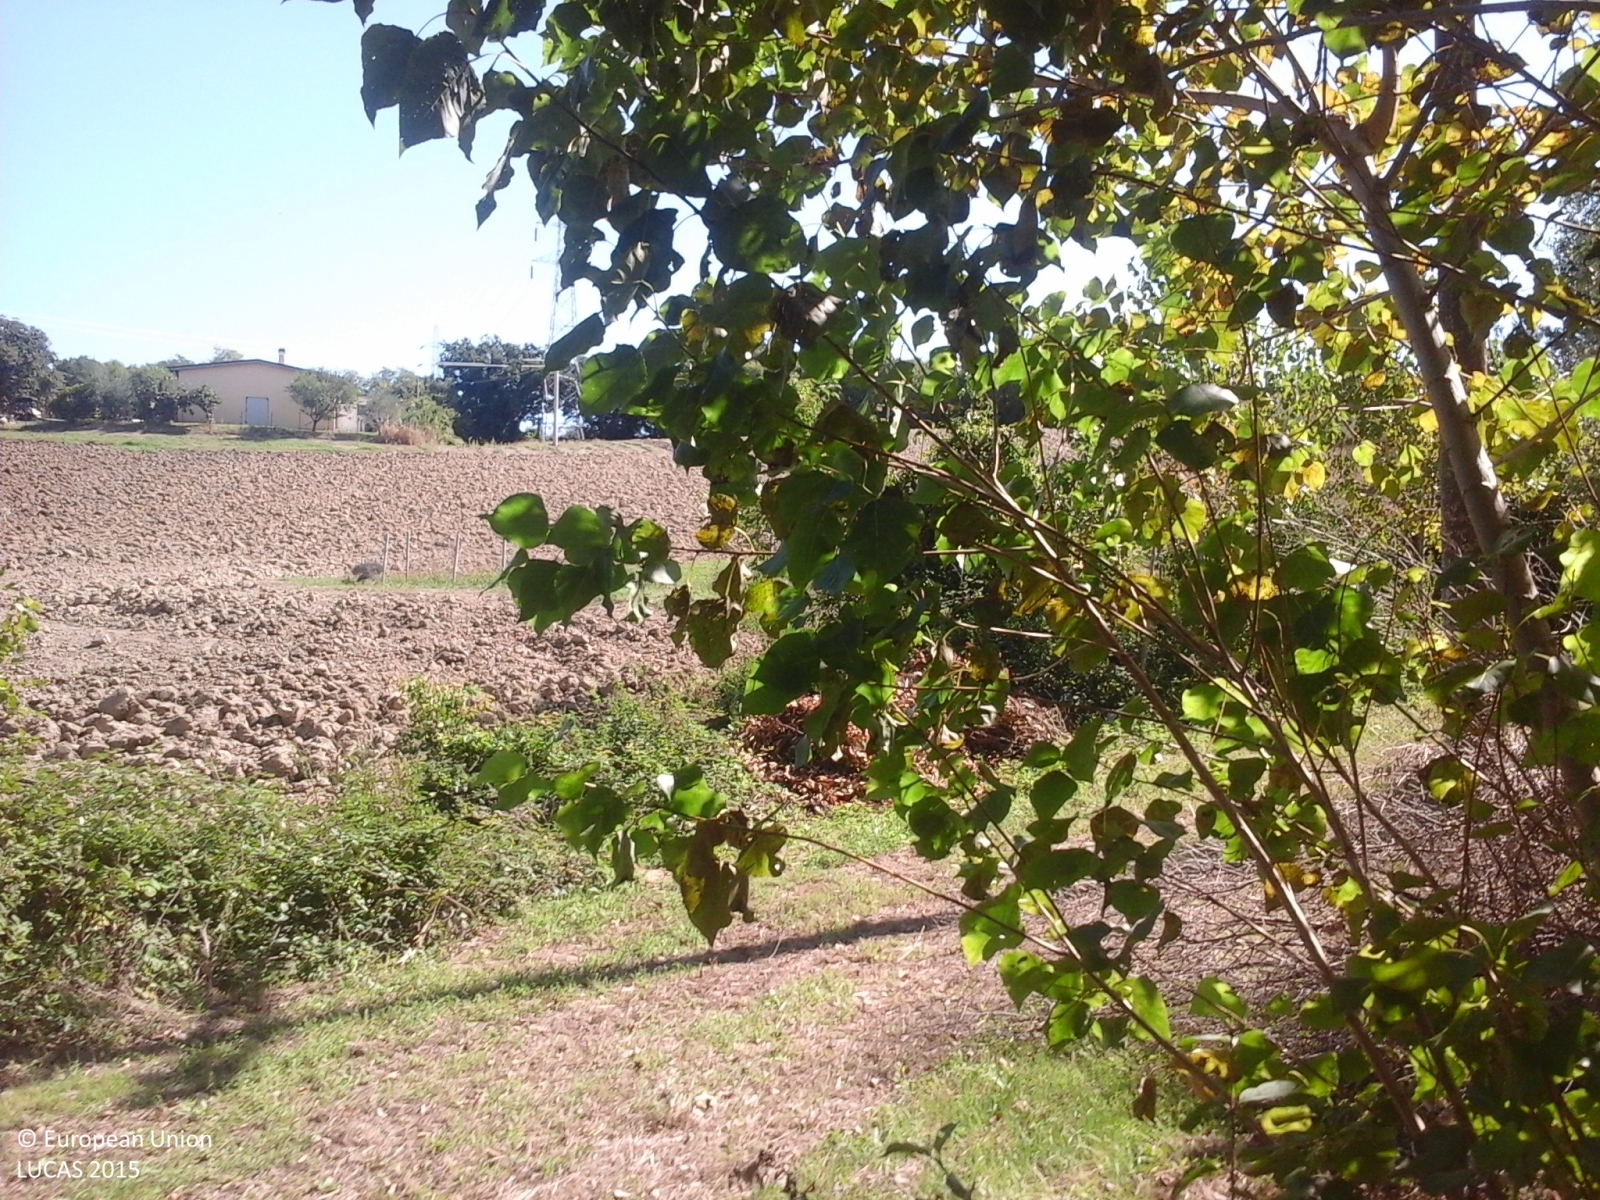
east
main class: Woodland
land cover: Broadleaved woodland
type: thermophilous deciduous forest
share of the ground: > 75 %
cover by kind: broadleaved forest trees 100 %
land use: Forestry
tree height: > 5 m
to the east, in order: Broadleaved woodland; Grassland with sparse tree/shrub cover; Electric lines; Shrubland without tree cover; Ditches and canals; Shrubland without tree cover; Grassland without tree/shrub cover; Fences; Inland fresh water bodies; Fences; Grassland without tree/shrub cover; Durum wheat; Electric lines; Durum wheat; Fences; Broadleaved woodland; Artificial constructions in urban areas; Broadleaved woodland; Fences; Paved roads, cycling and walking lanes; Broadleaved woodland; Durum wheat
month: September
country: IT
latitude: 43.7248
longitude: 13.1580
